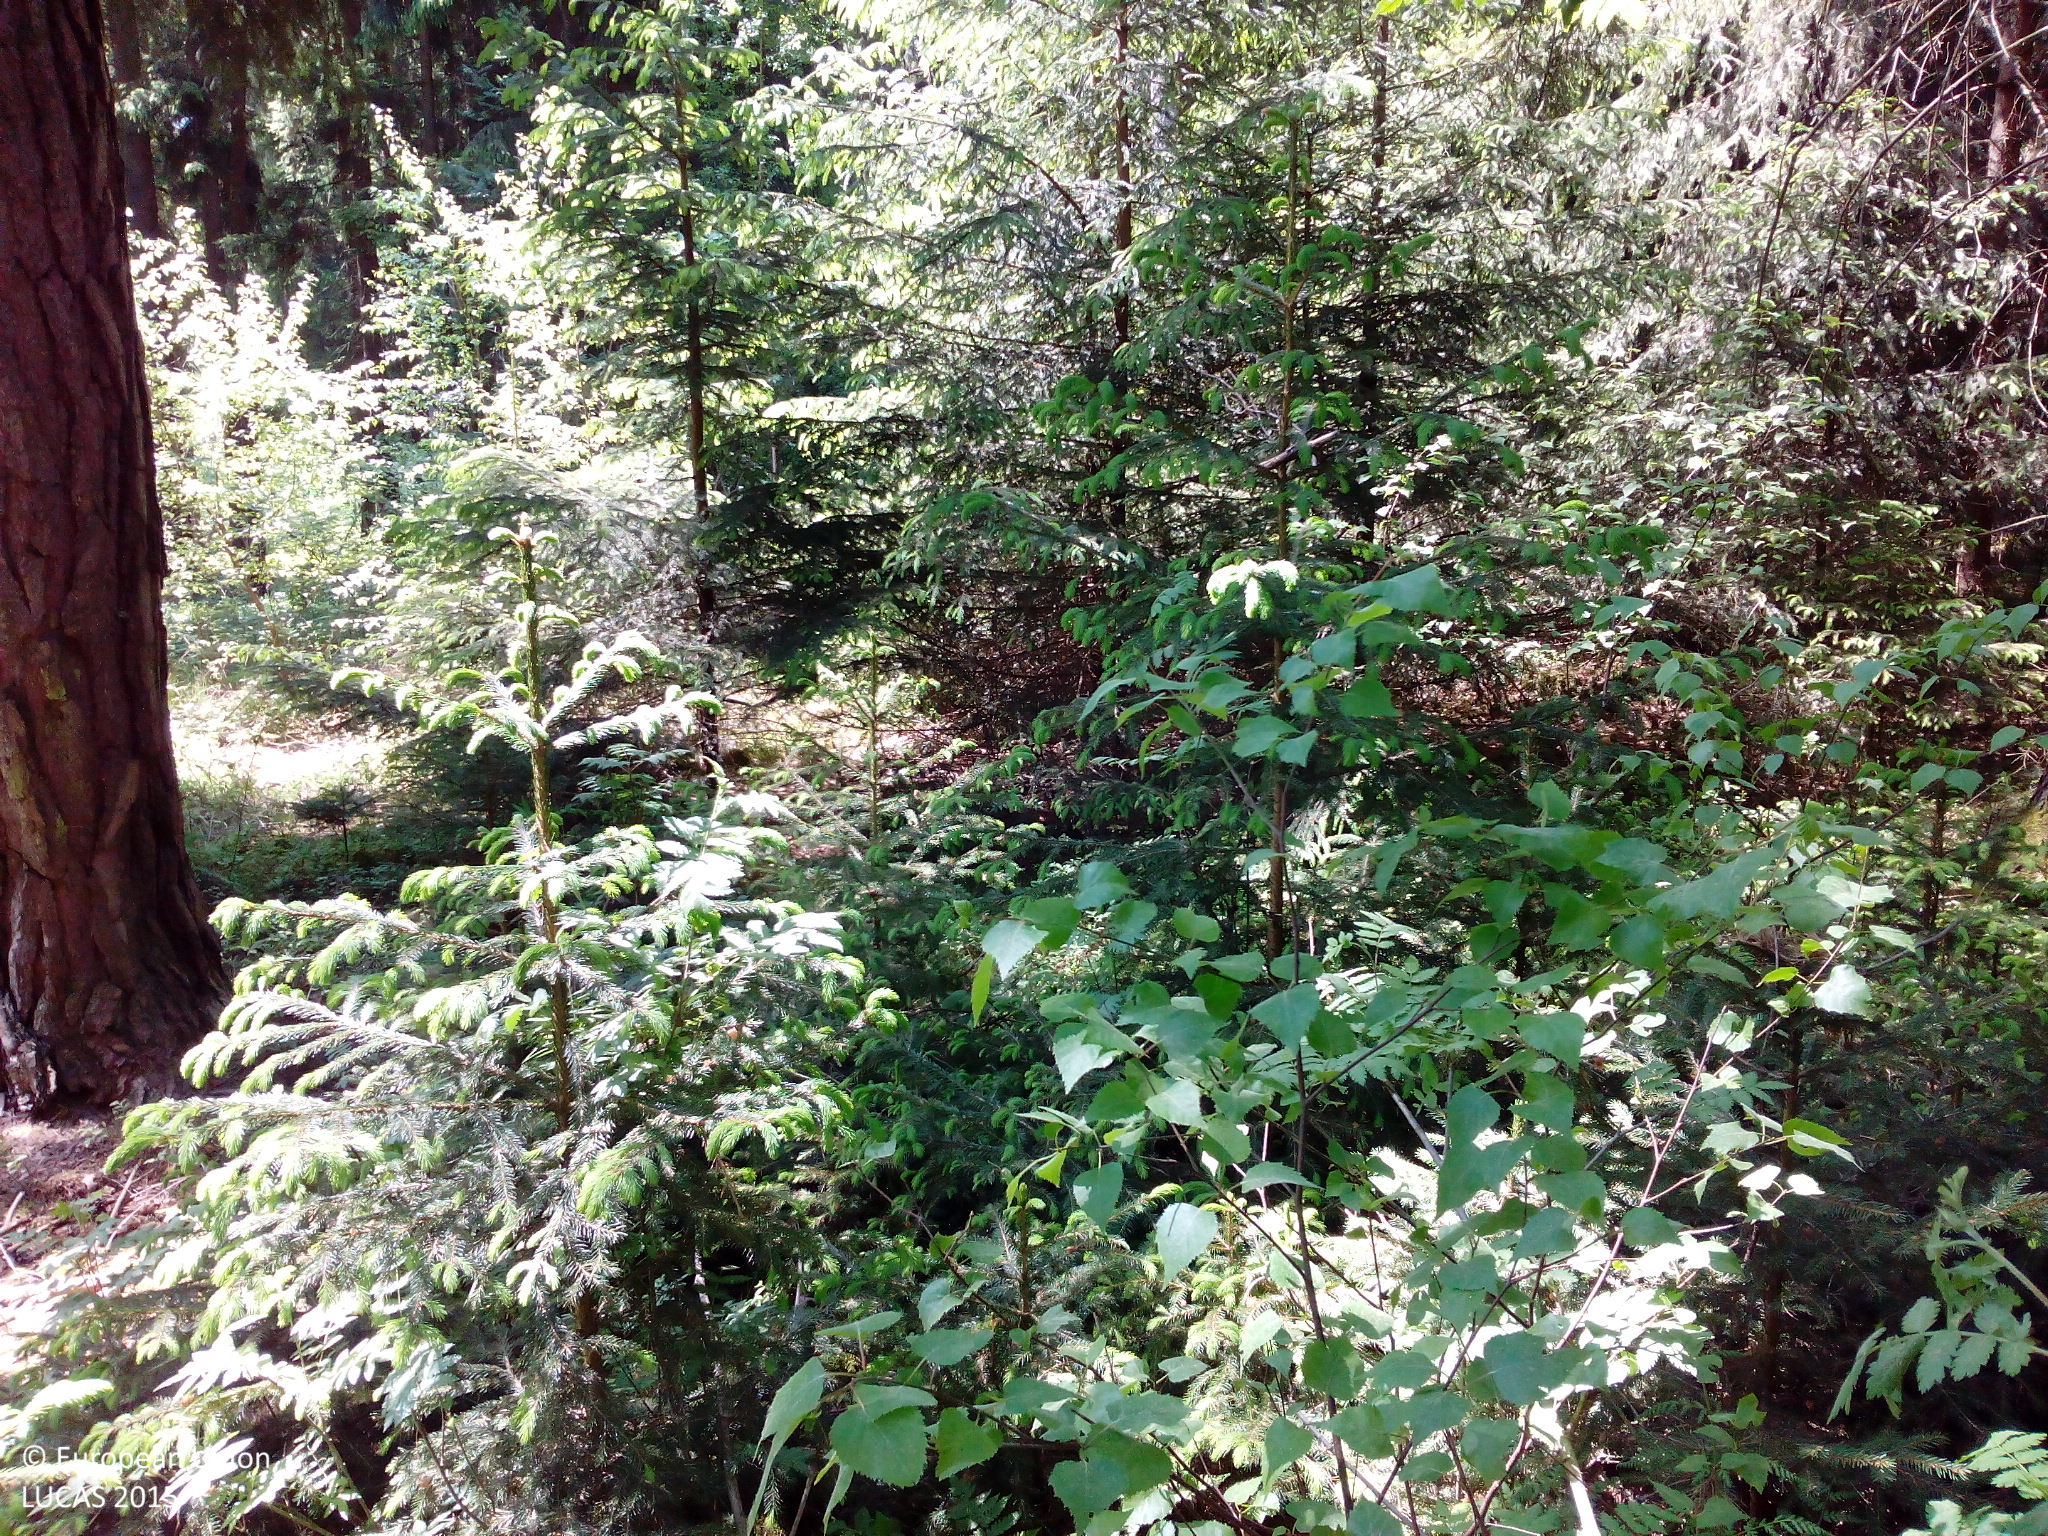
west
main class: Woodland
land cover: Other coniferous woodland
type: hemiboreal forest and nemoral coniferous forest and mixed broadleaved-coniferous forest
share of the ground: > 75 %
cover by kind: coniferous forest trees 75 %, herbaceous plants 10 %, lichens and mosses 10 %, broadleaved forest trees 5 %
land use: Forestry
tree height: > 5 m
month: May
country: DE
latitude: 49.1311
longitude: 11.4933
